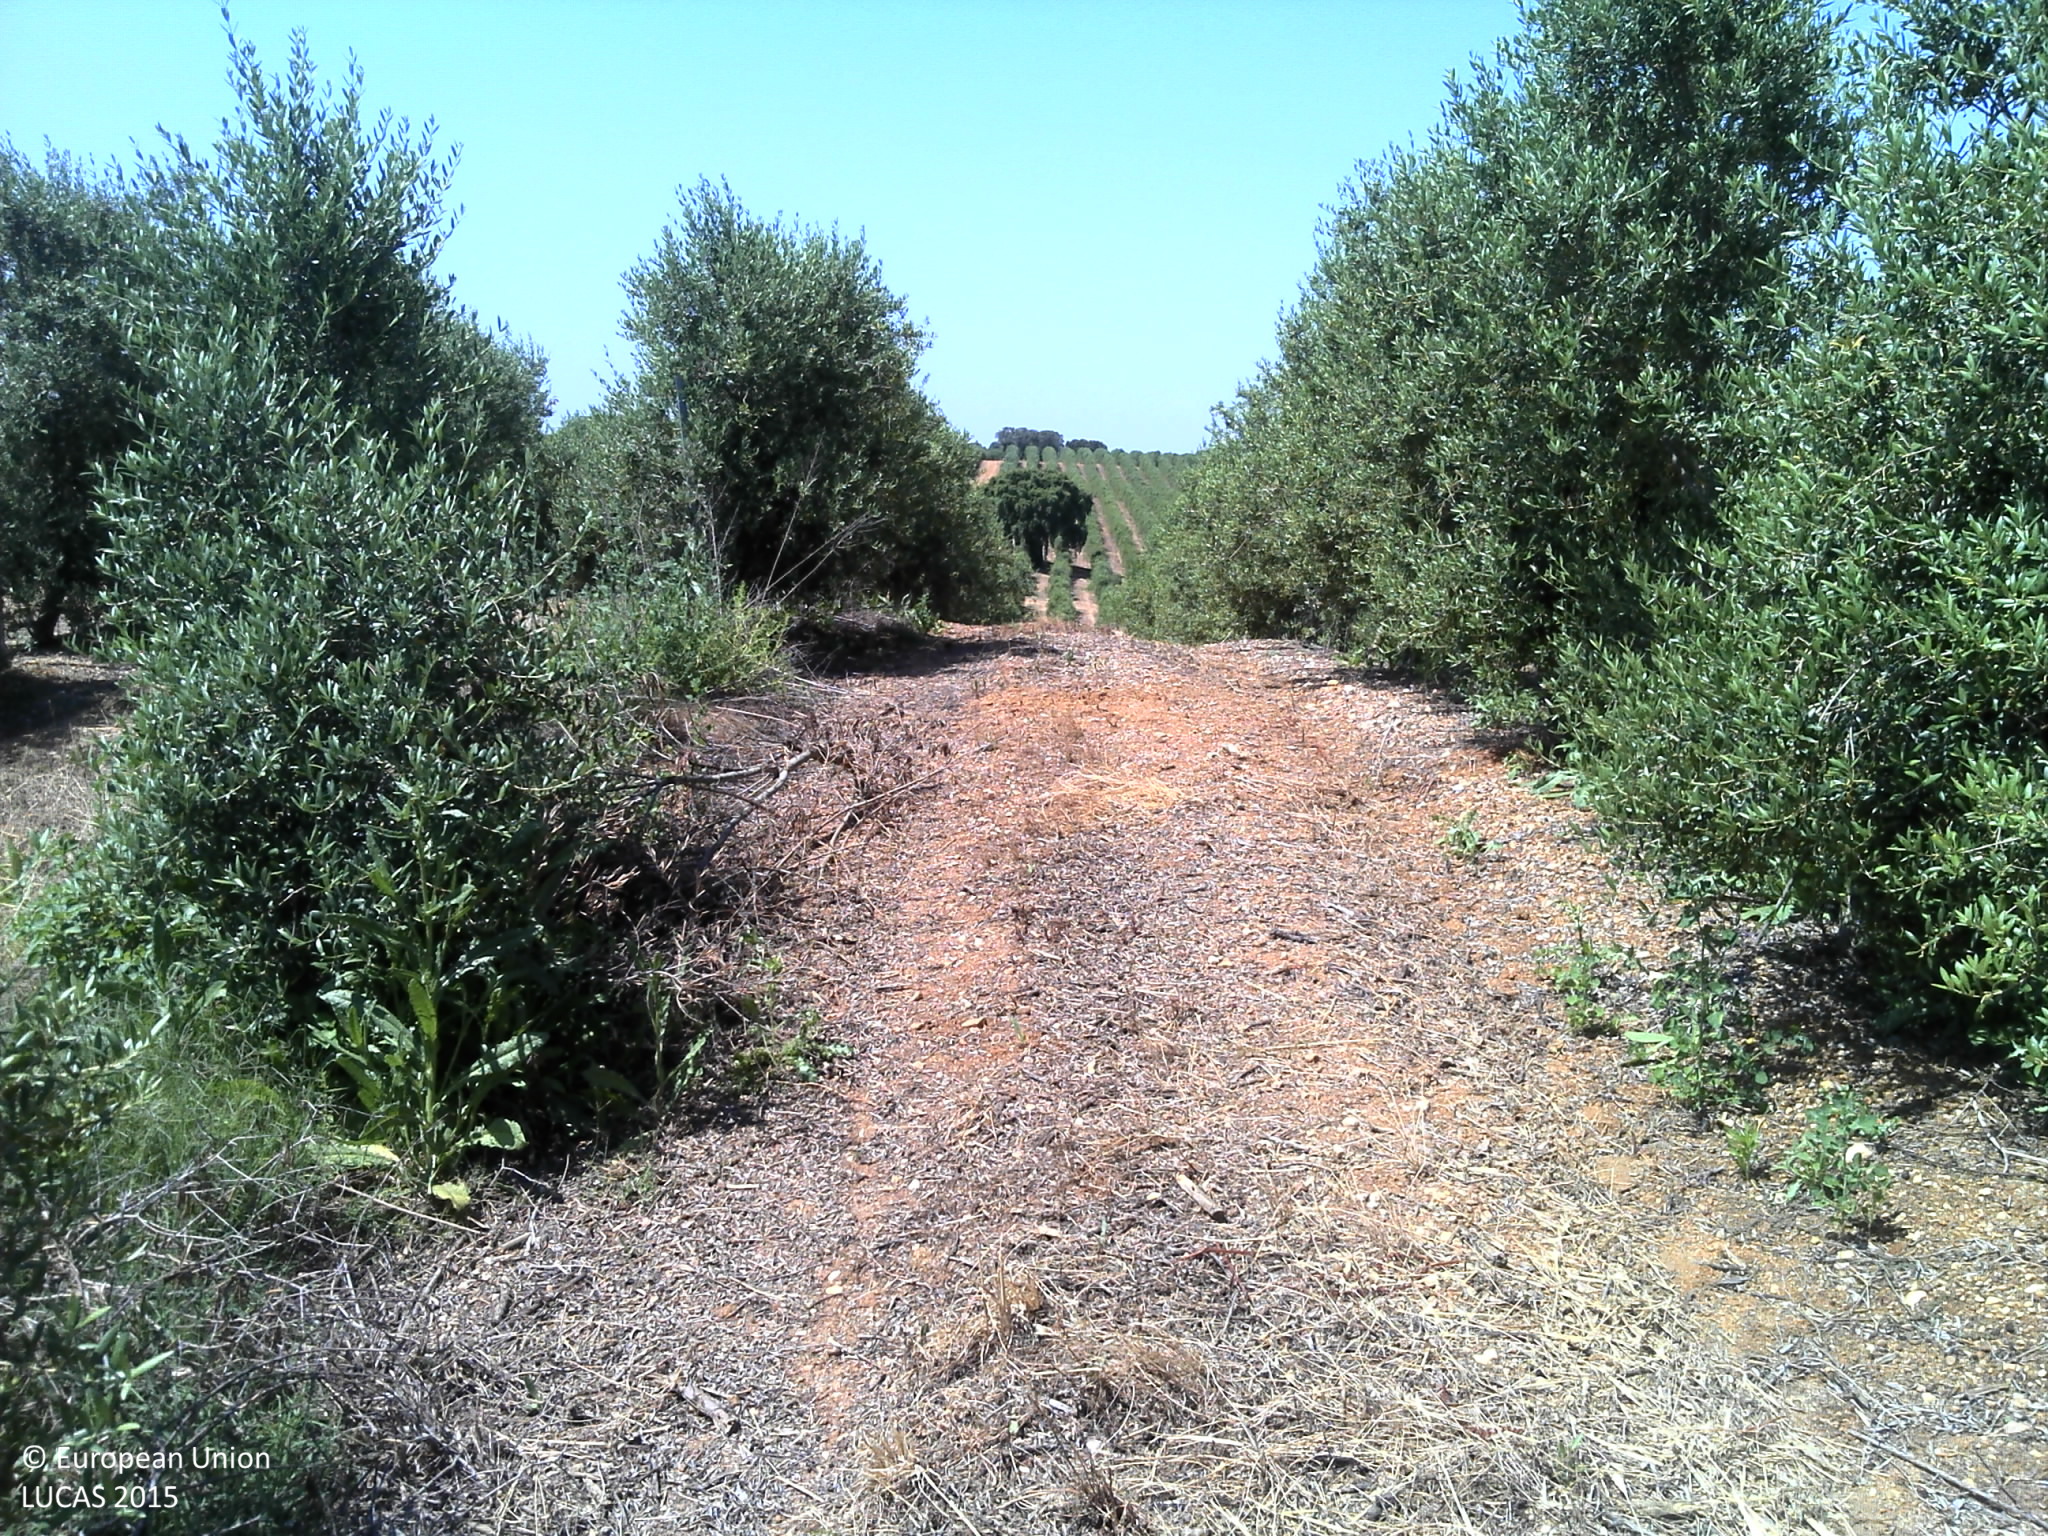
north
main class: Cropland
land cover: Olive groves
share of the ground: 25 - 50 %
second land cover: Spontaneously vegetated surfaces
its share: 10 - 25 %
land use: Agriculture (excluding fallow land and kitchen gardens)
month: June
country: PT
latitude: 37.8762
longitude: -8.3286
